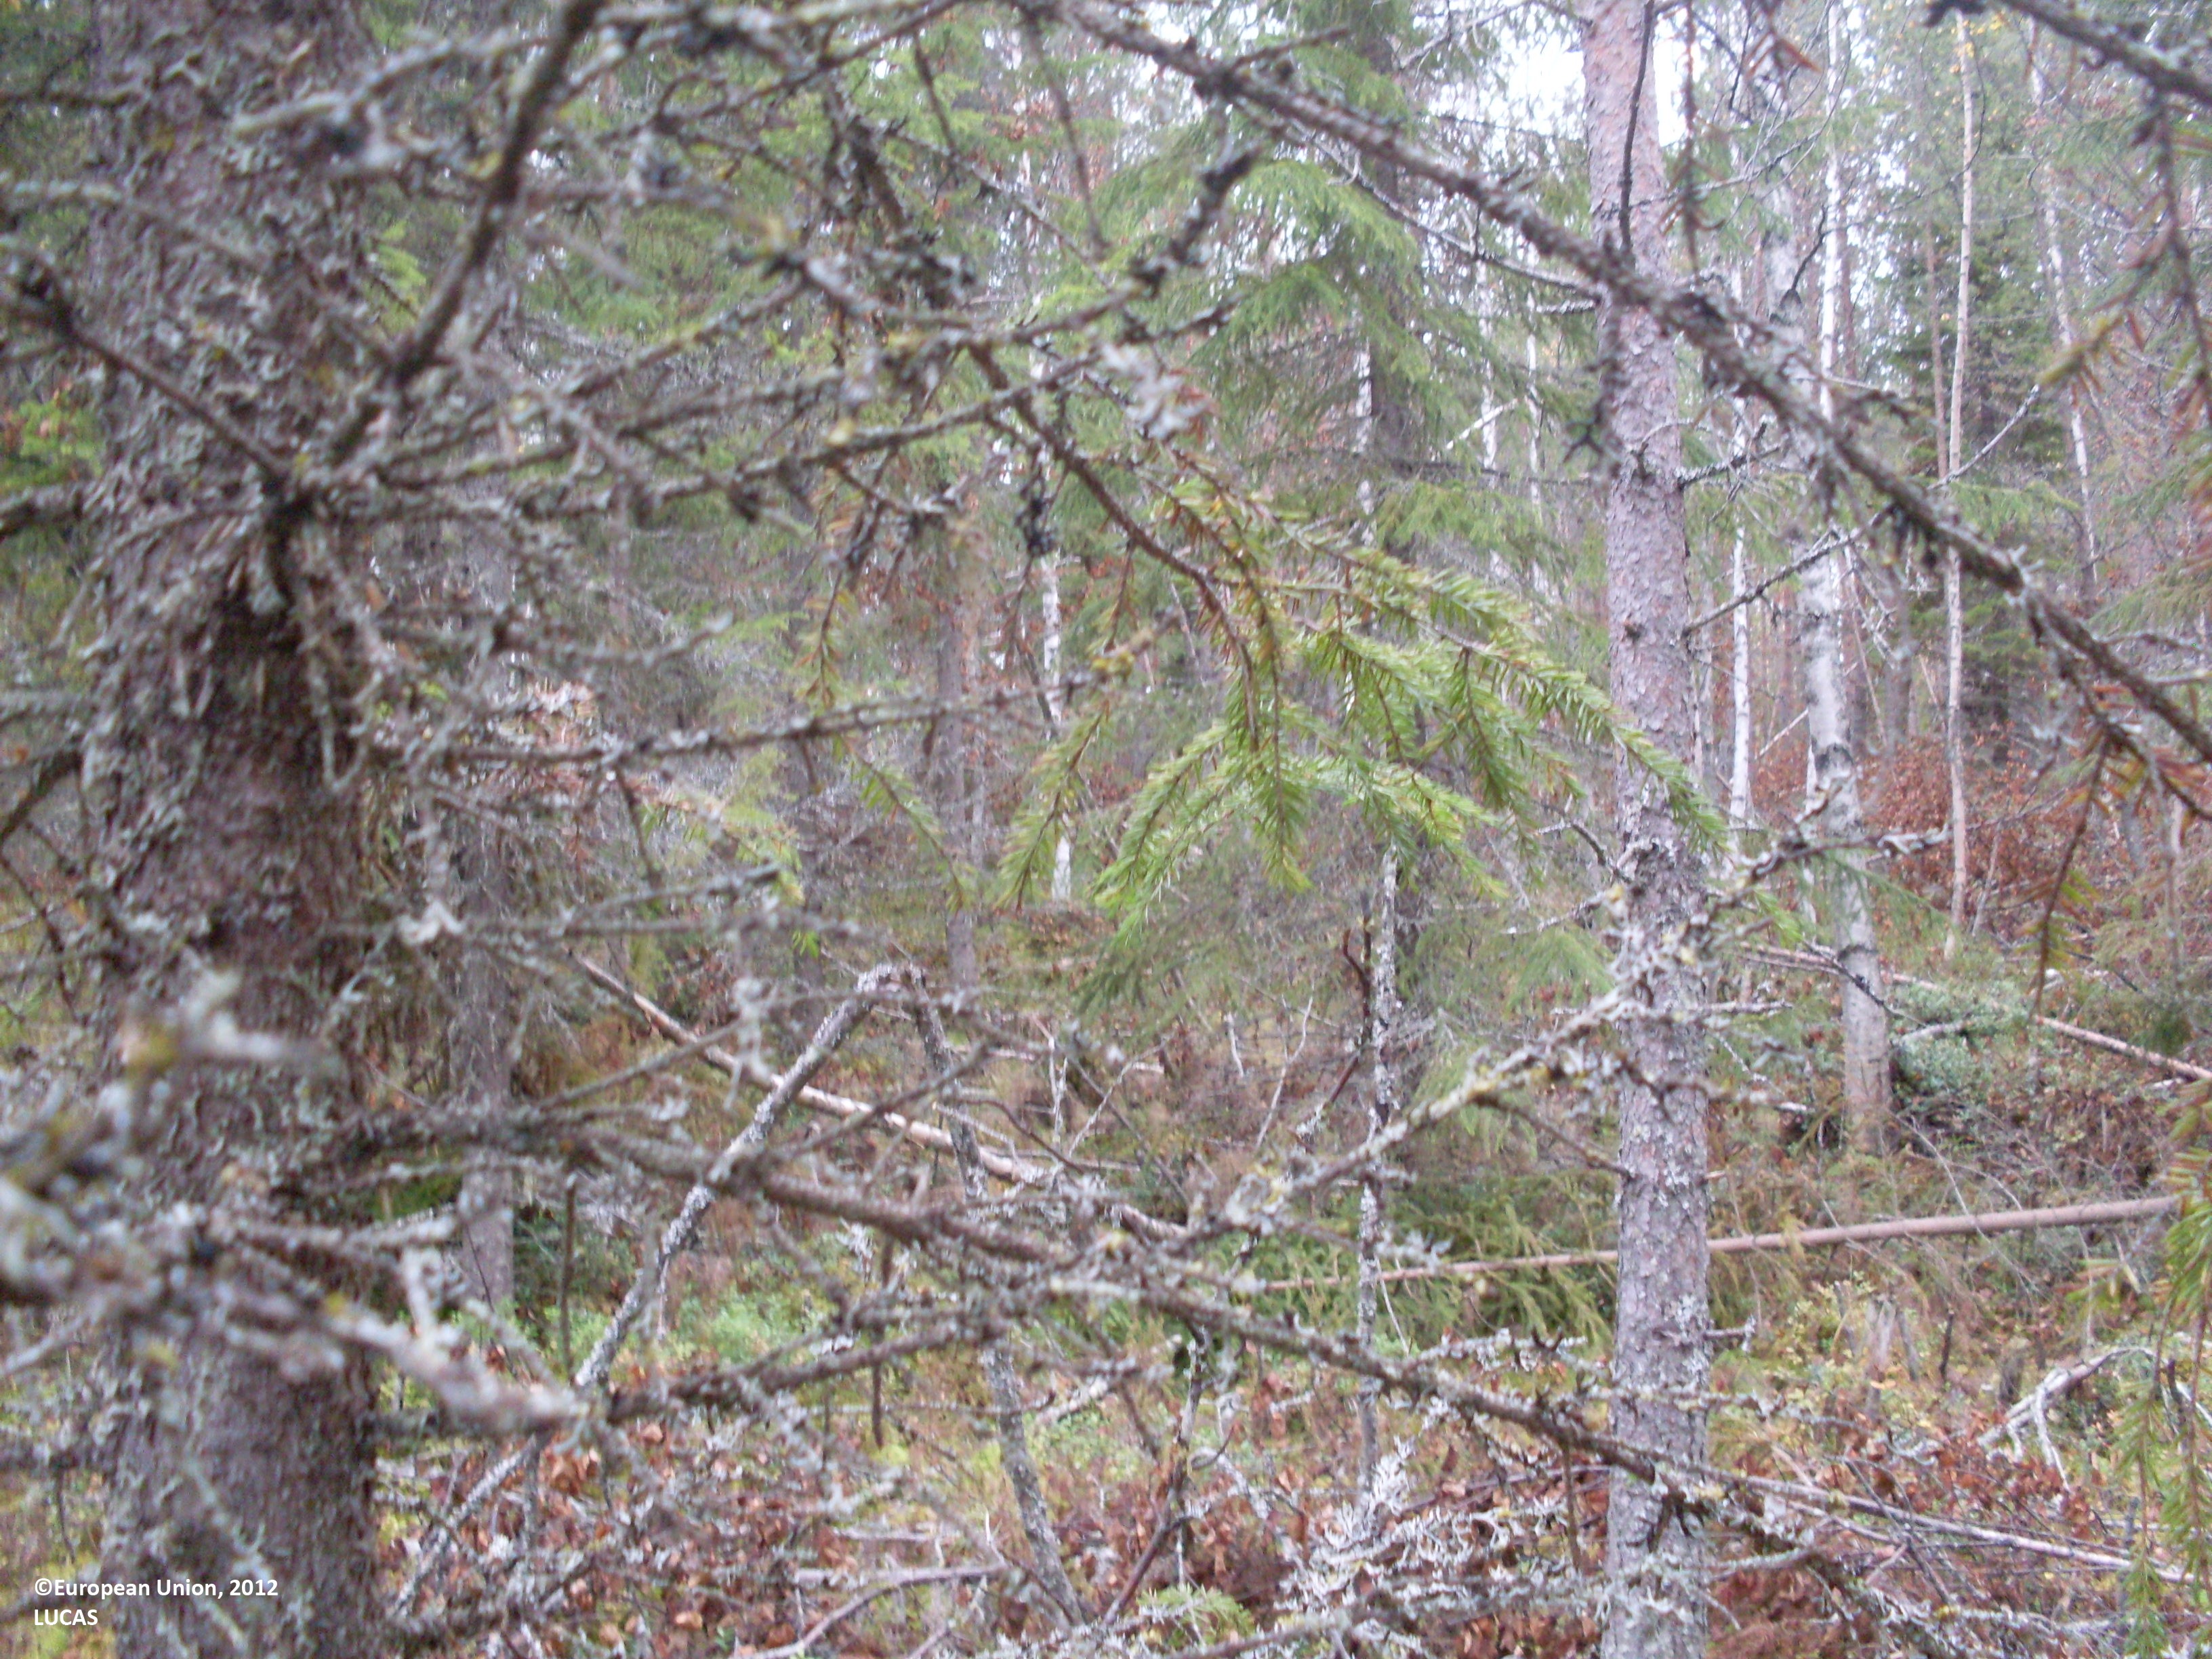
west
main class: Woodland
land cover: Spruce dominated mixed woodland
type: boreal forest
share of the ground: > 75 %
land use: Forestry
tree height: > 5 m
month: September
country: FI
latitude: 64.6767
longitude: 28.8127
